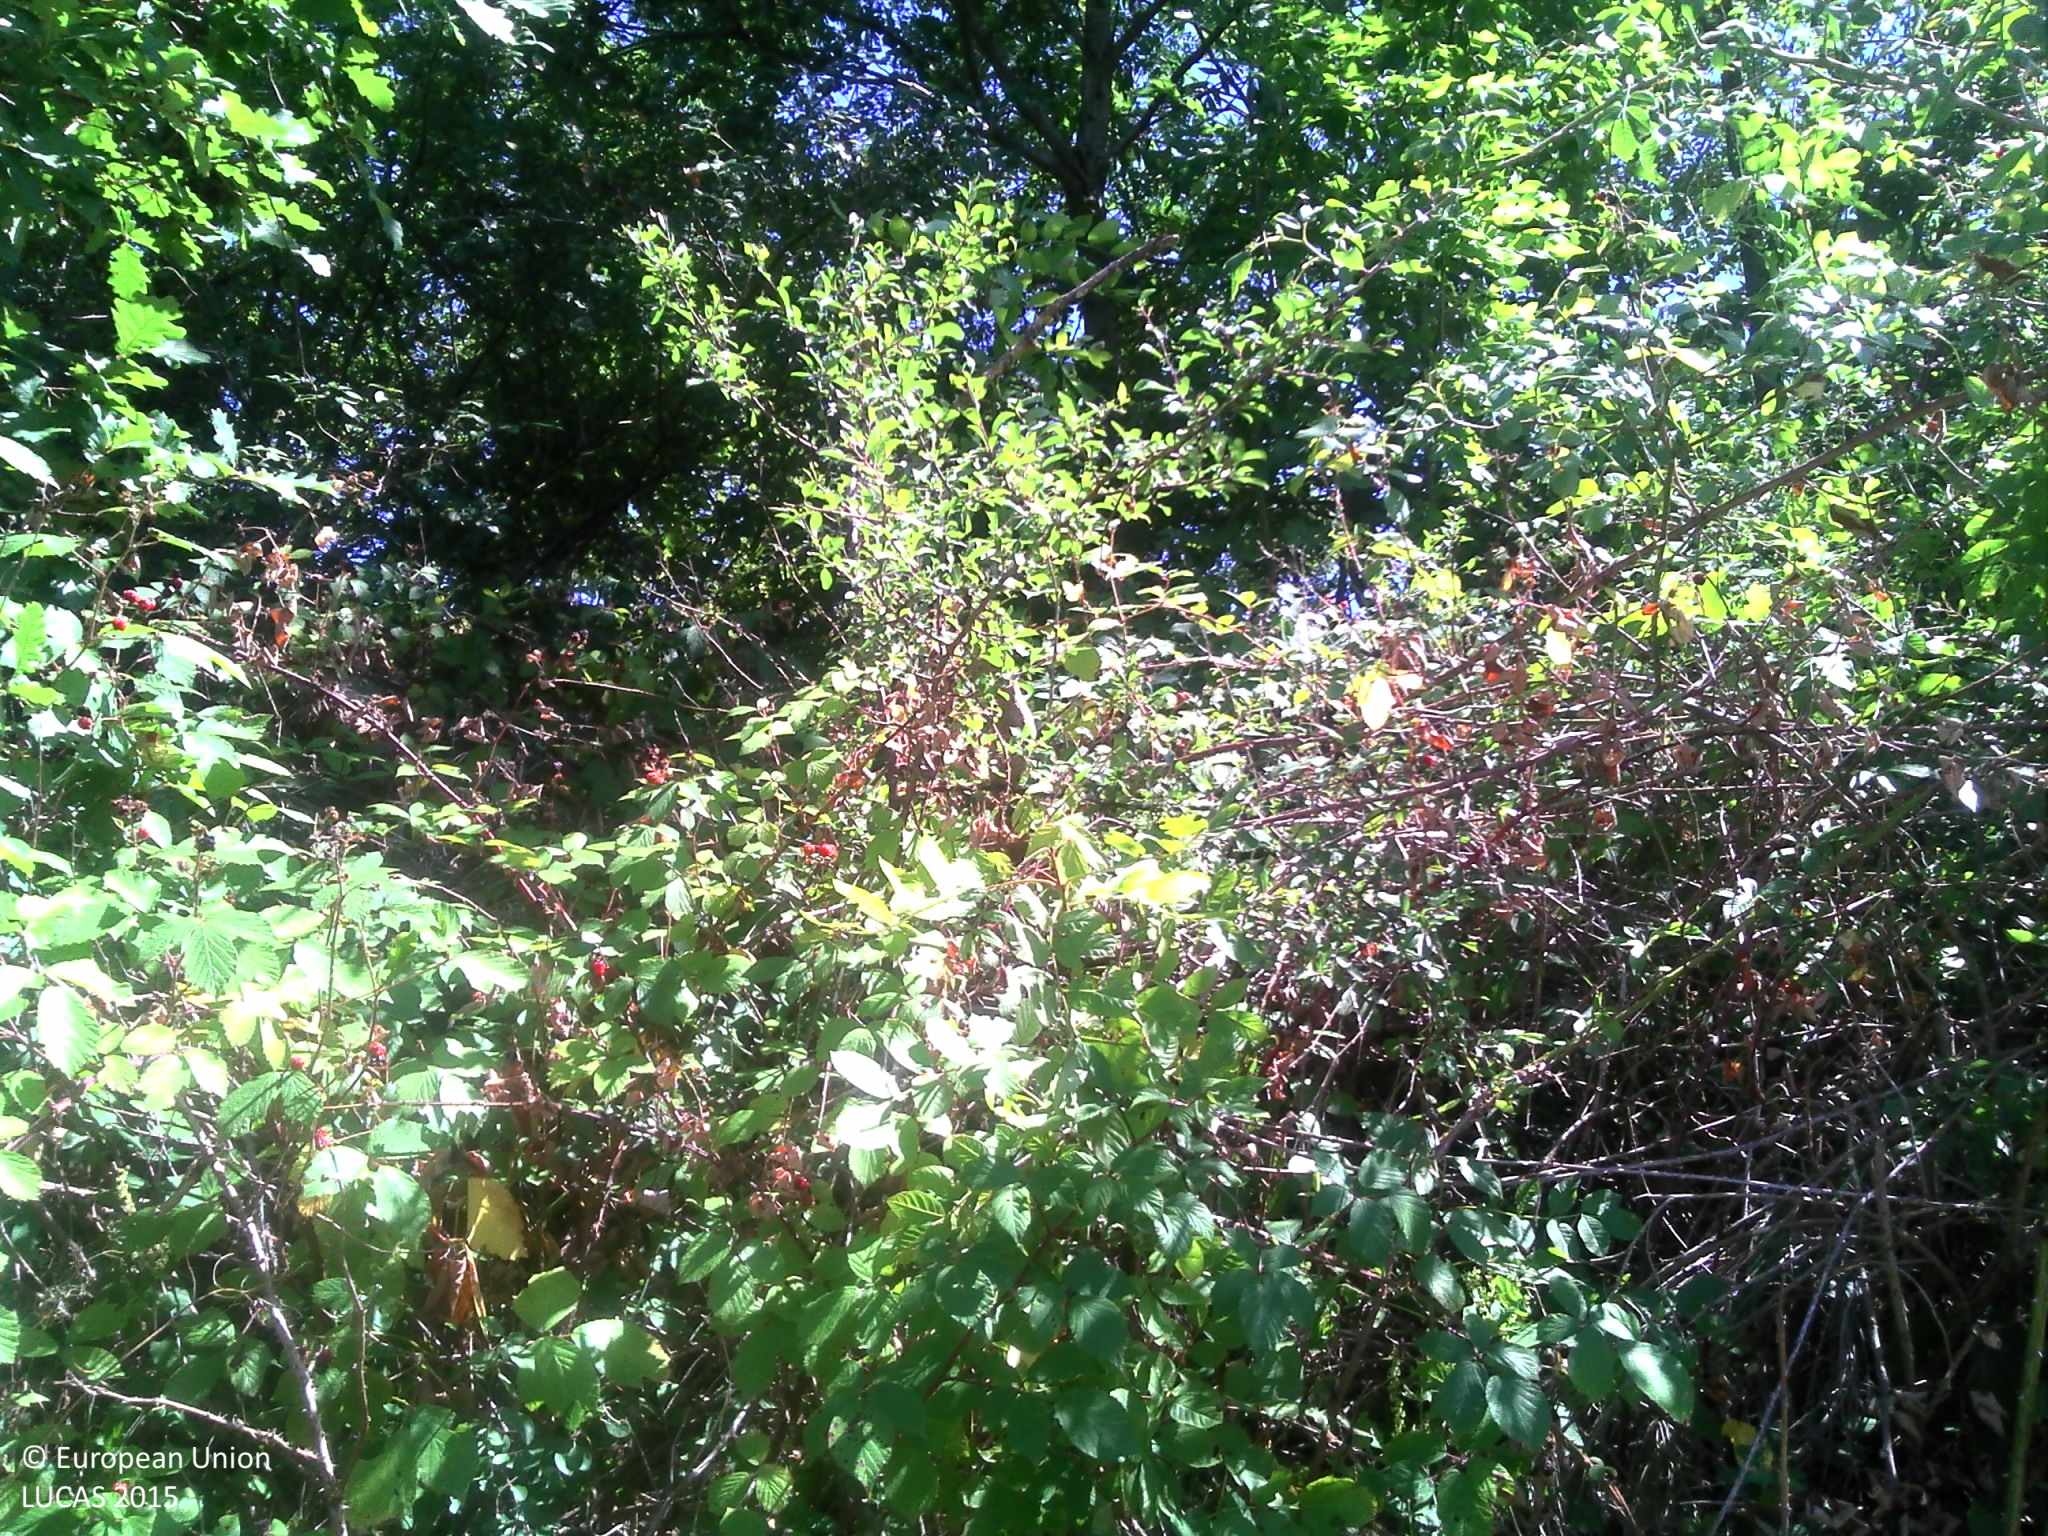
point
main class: Woodland
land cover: Broadleaved woodland
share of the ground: > 75 %
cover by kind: broadleaved forest trees 70 %, herbaceous plants 30 %
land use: Semi-natural and natural areas not in use
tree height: > 5 m
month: July
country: FR
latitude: 44.9864
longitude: 4.5897
